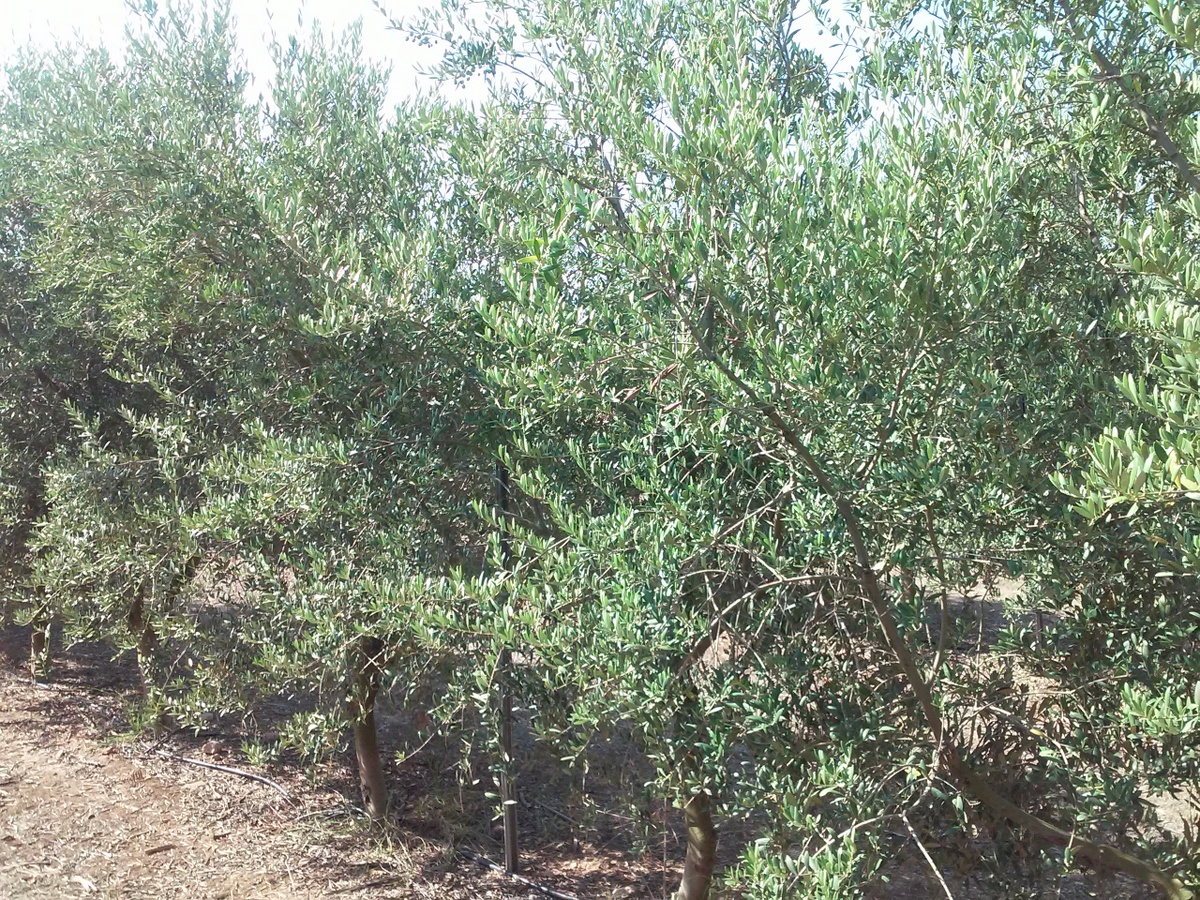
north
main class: Cropland
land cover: Olive groves
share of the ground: 10 - 25 %
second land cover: Other bare soil
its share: > 75 %
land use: Agriculture (excluding fallow land and kitchen gardens)
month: August
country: ES
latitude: 41.0911
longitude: 0.6228
